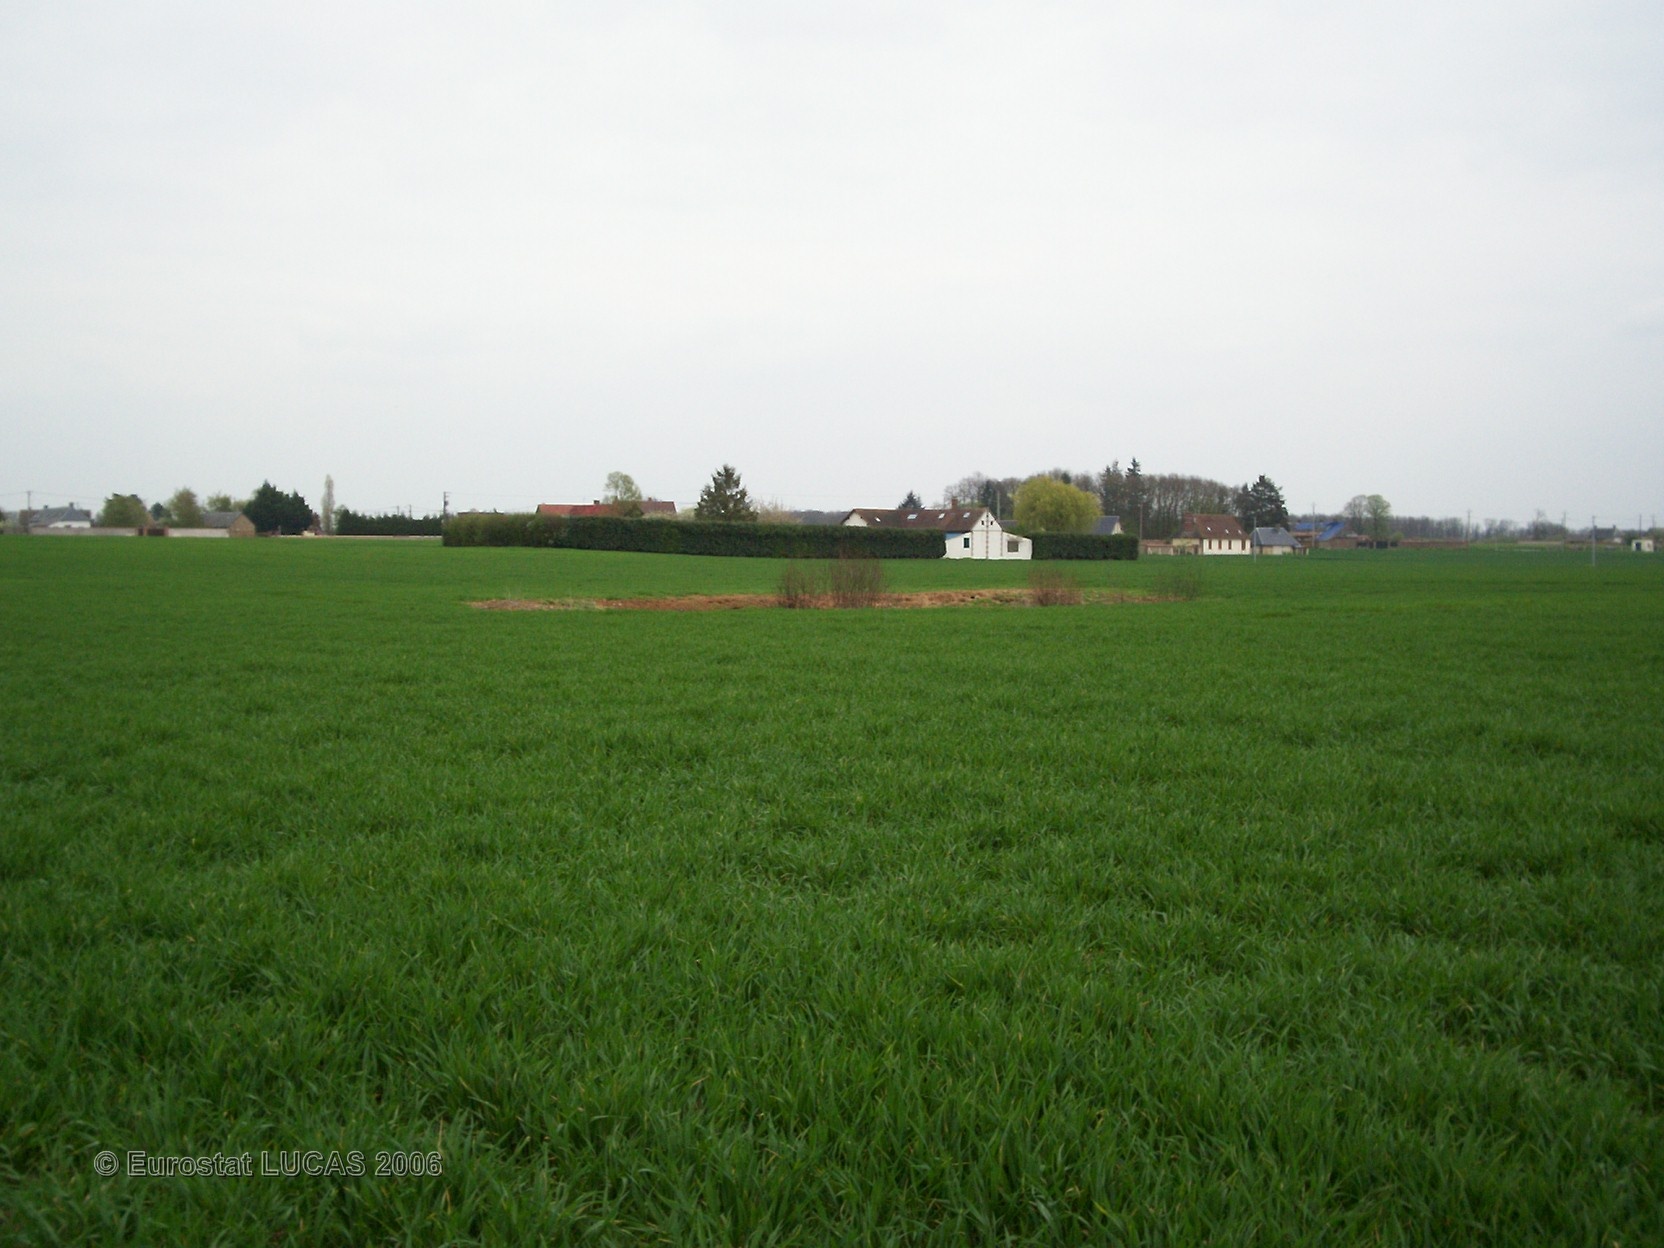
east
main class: Cropland
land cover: Common wheat
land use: Agriculture (excluding fallow land and kitchen gardens)
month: April
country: FR
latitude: 48.8568
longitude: 1.0791
